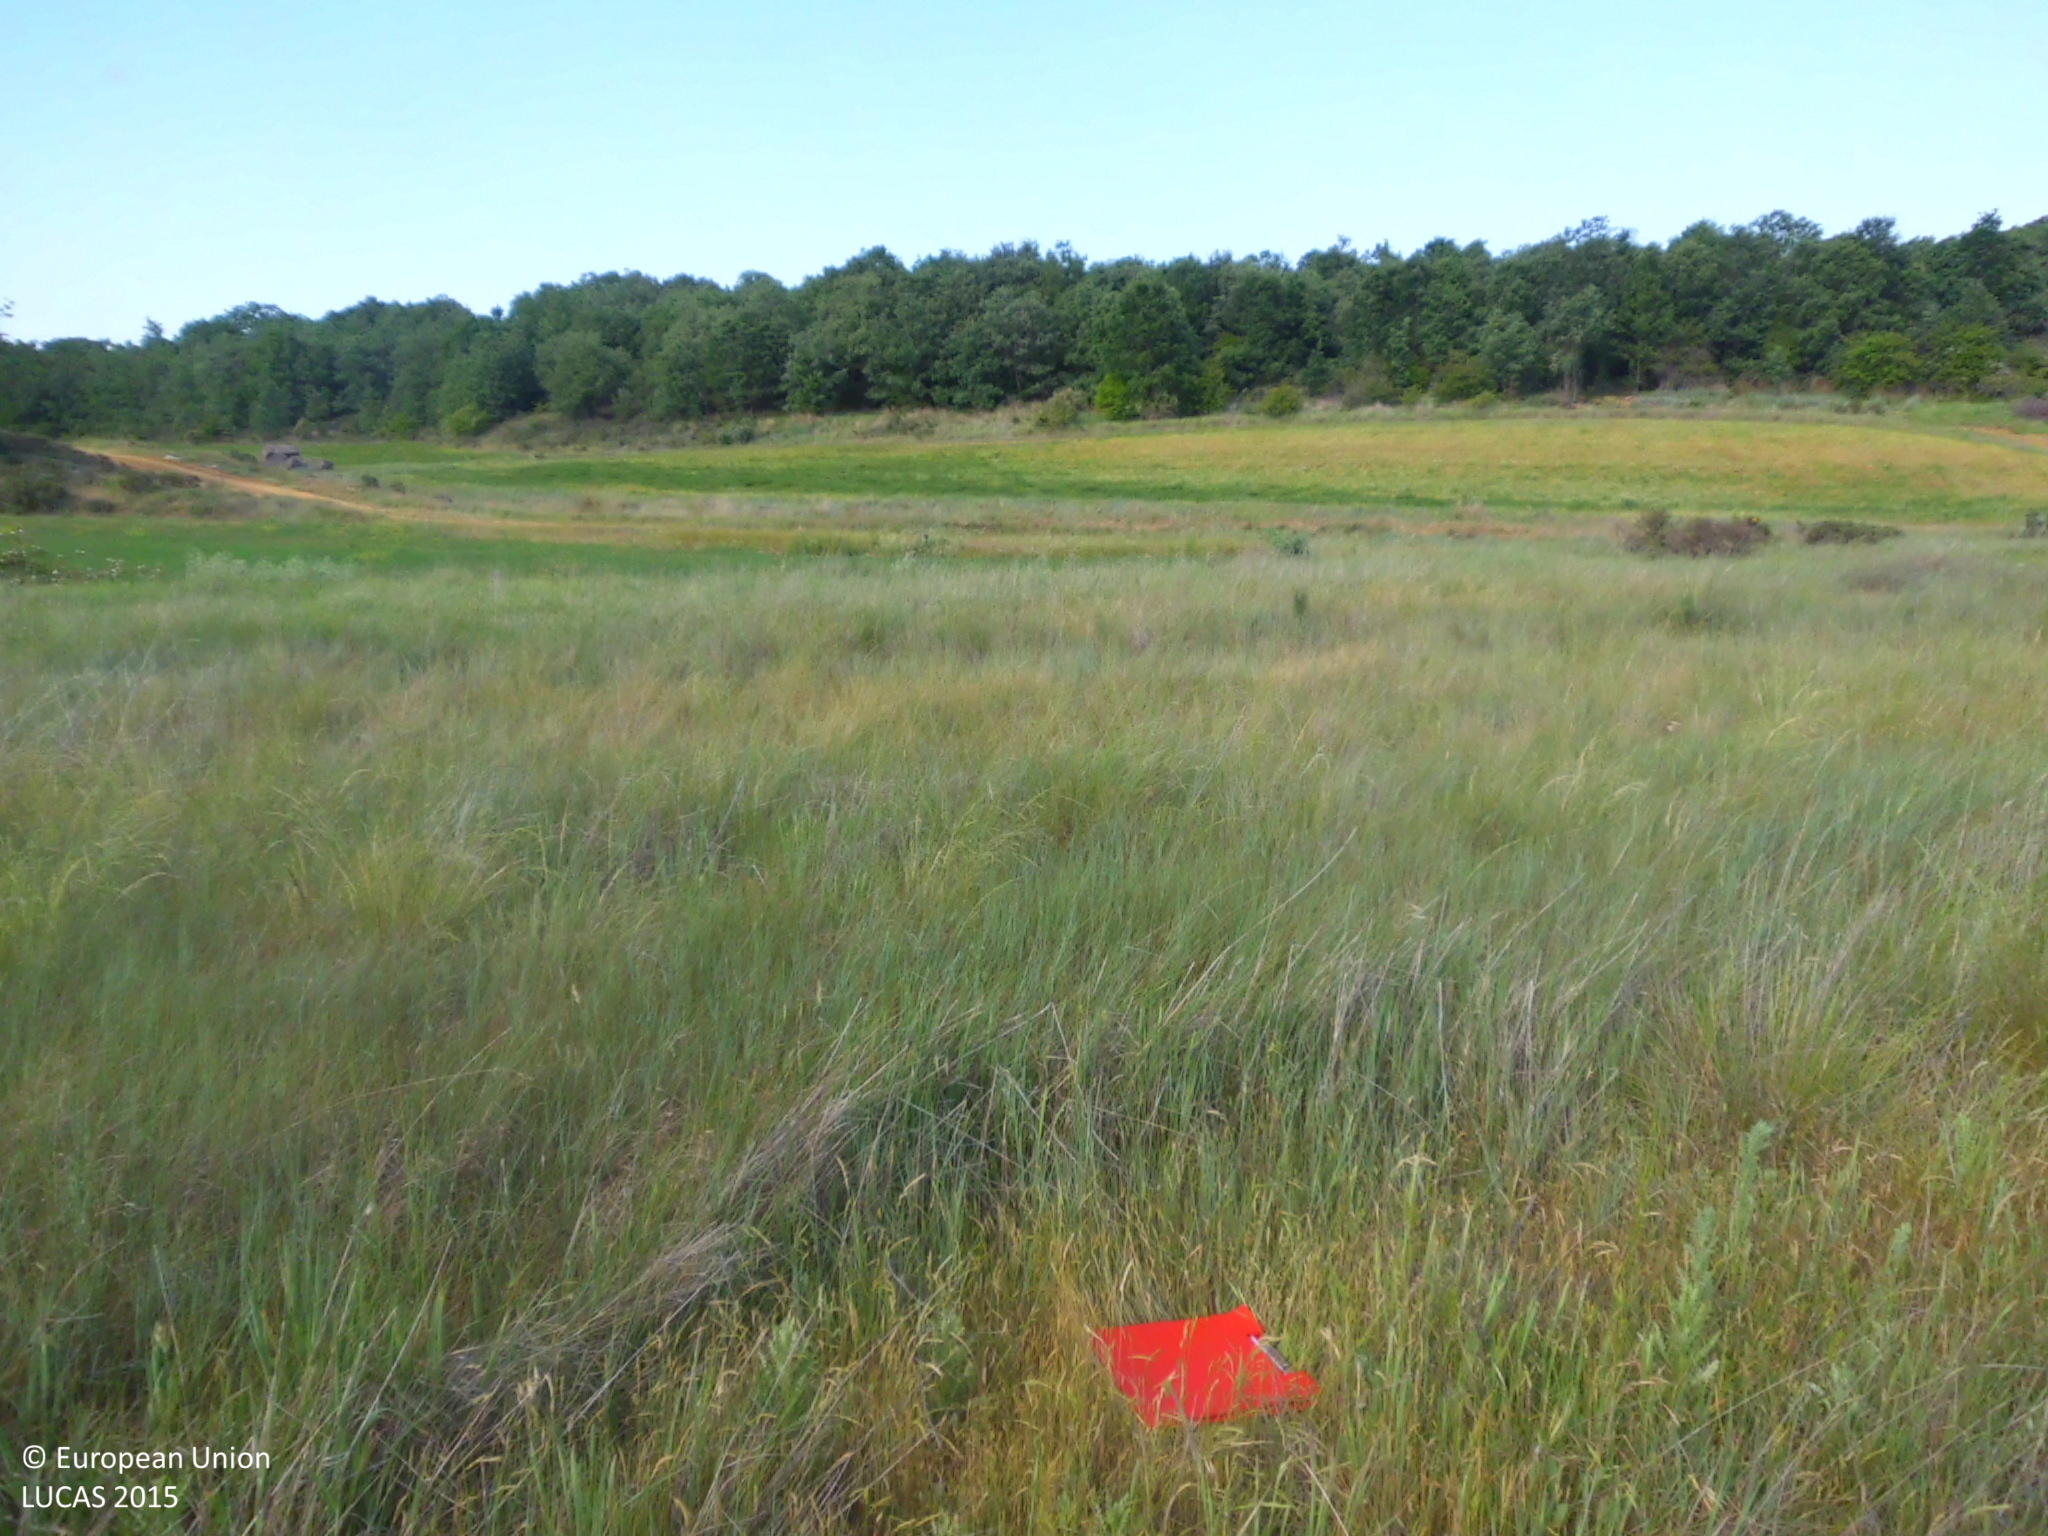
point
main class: Grassland
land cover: Grassland without tree/shrub cover
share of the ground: > 75 %
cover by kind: herbaceous plants 100 %
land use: Agriculture (excluding fallow land and kitchen gardens)
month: June
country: ES
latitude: 42.4952
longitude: -4.4195
